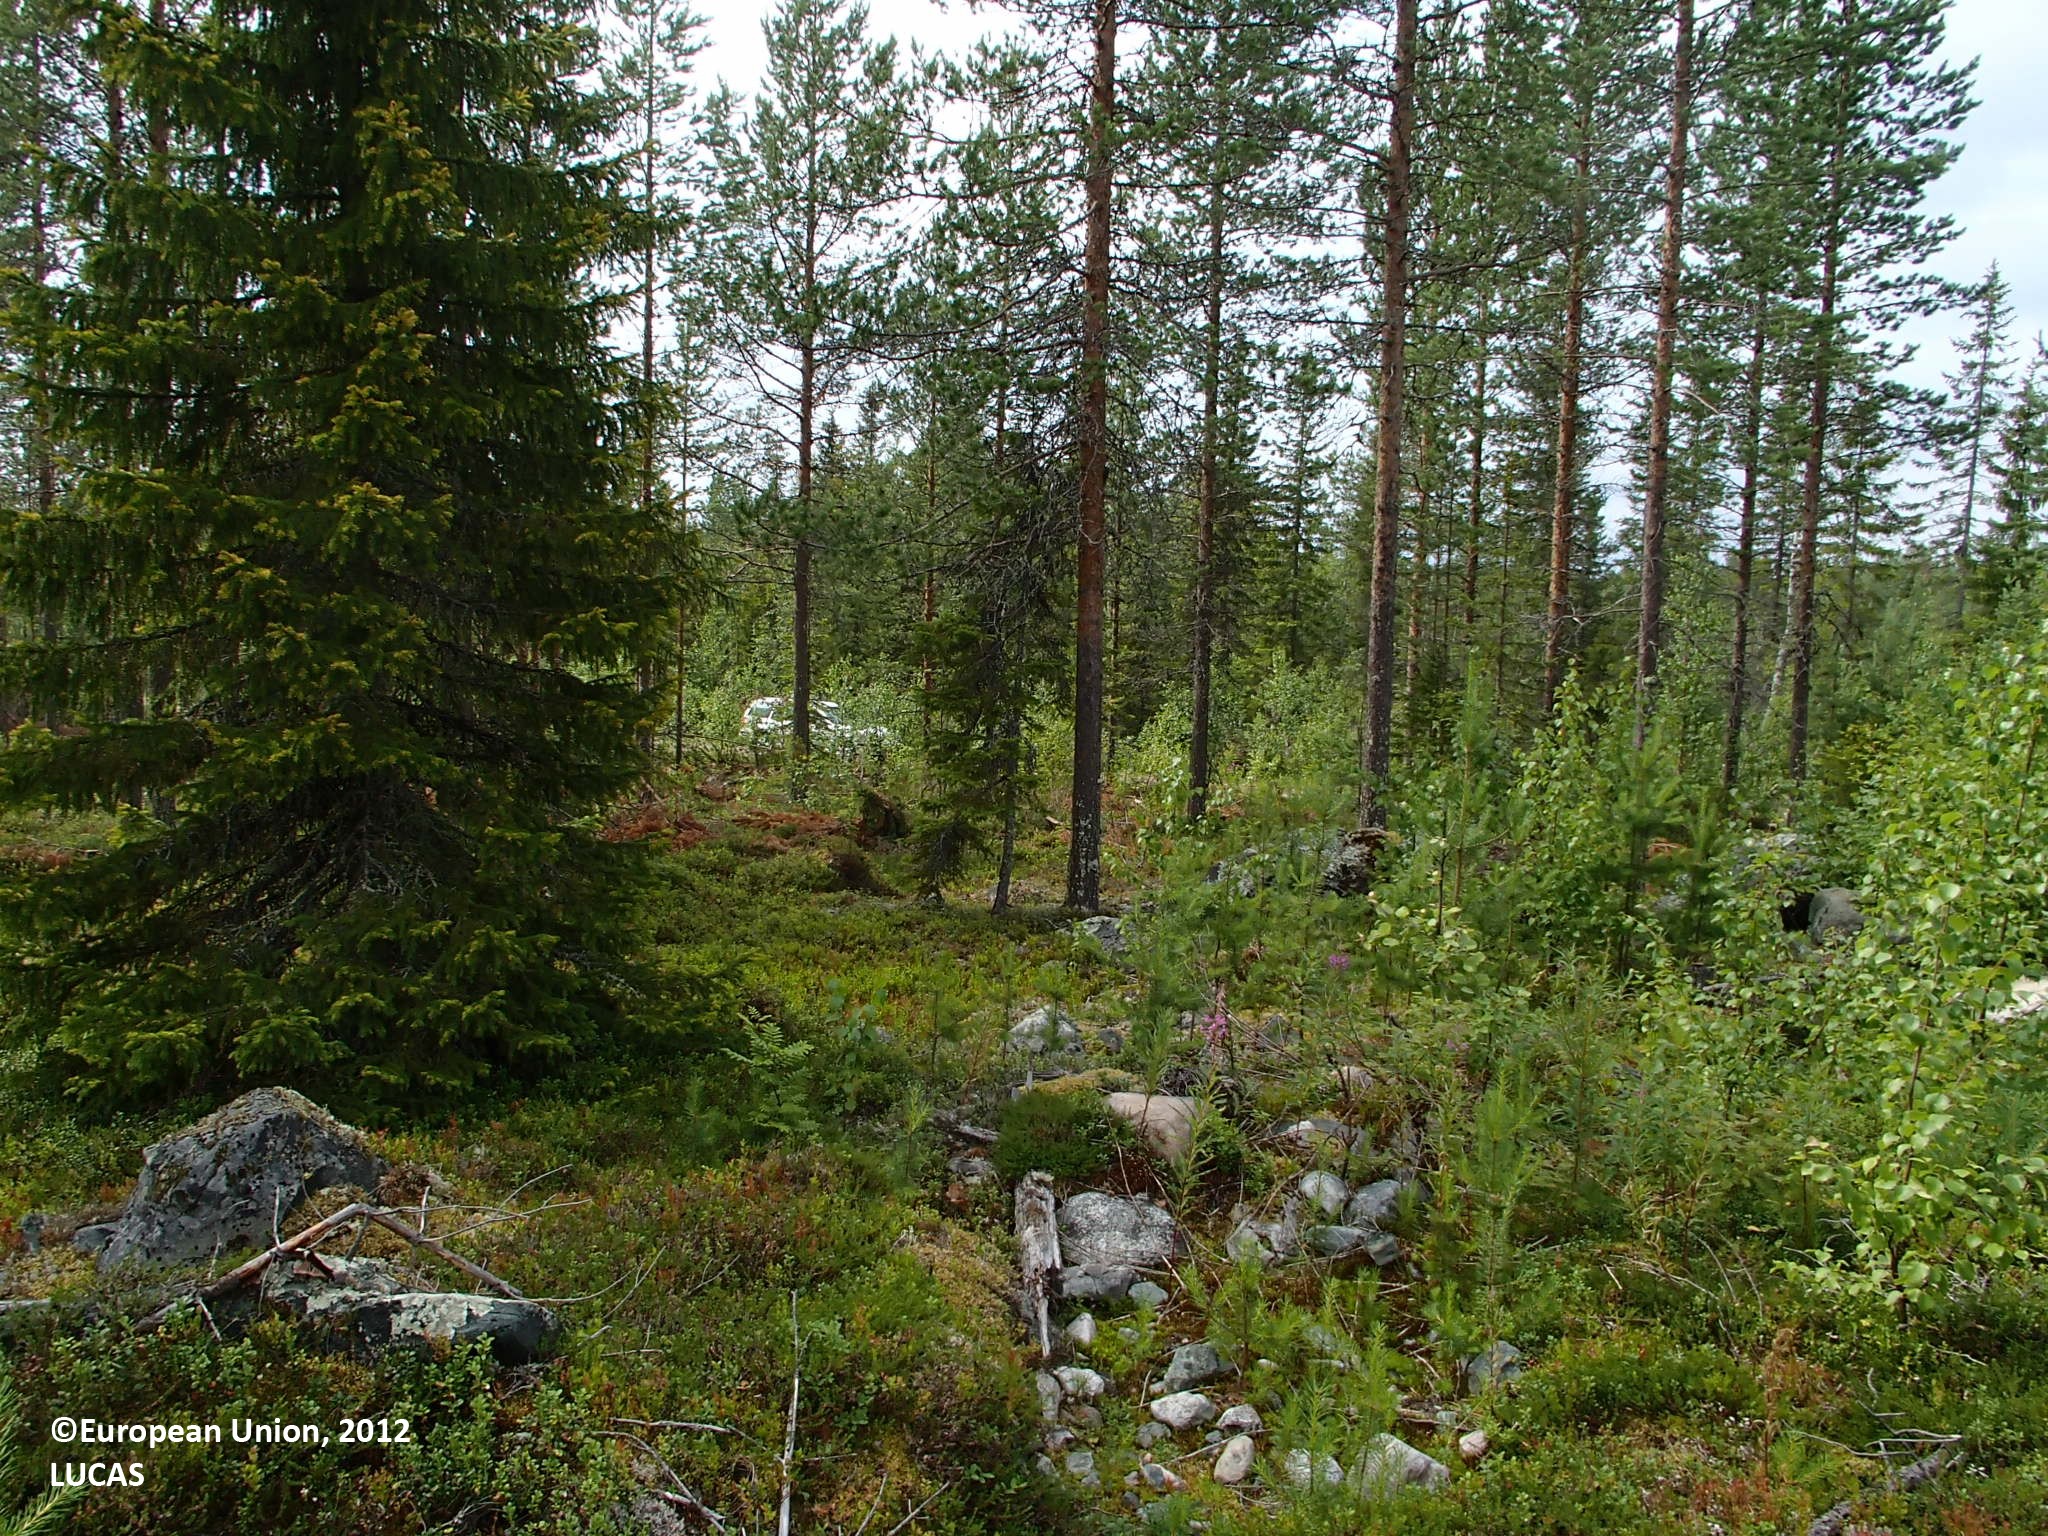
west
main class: Woodland
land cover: Pine dominated coniferous woodland
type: boreal forest
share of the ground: 10 - 25 %
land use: Forestry
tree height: > 5 m
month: July
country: FI
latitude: 66.1965
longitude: 25.3639
